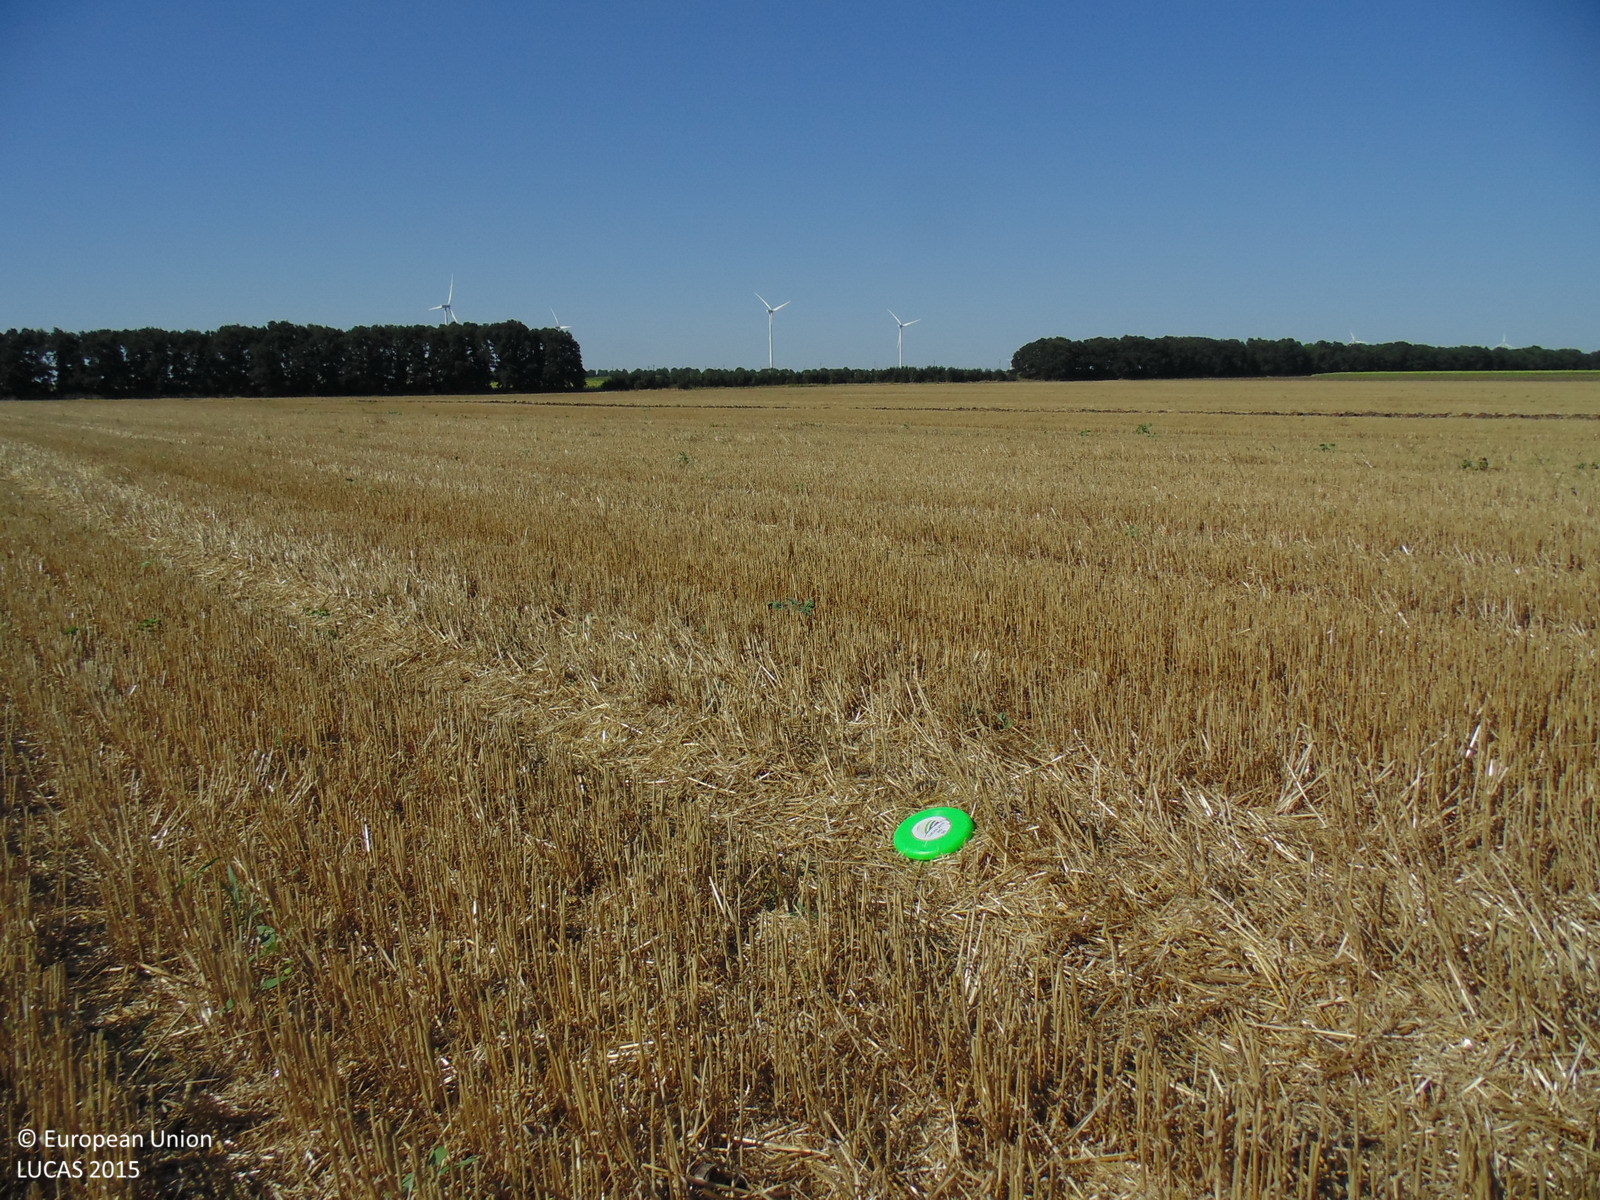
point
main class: Cropland
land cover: Common wheat
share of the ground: 50 - 75 %
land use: Agriculture (excluding fallow land and kitchen gardens)
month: August
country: BG
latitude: 43.4827
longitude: 28.2922
